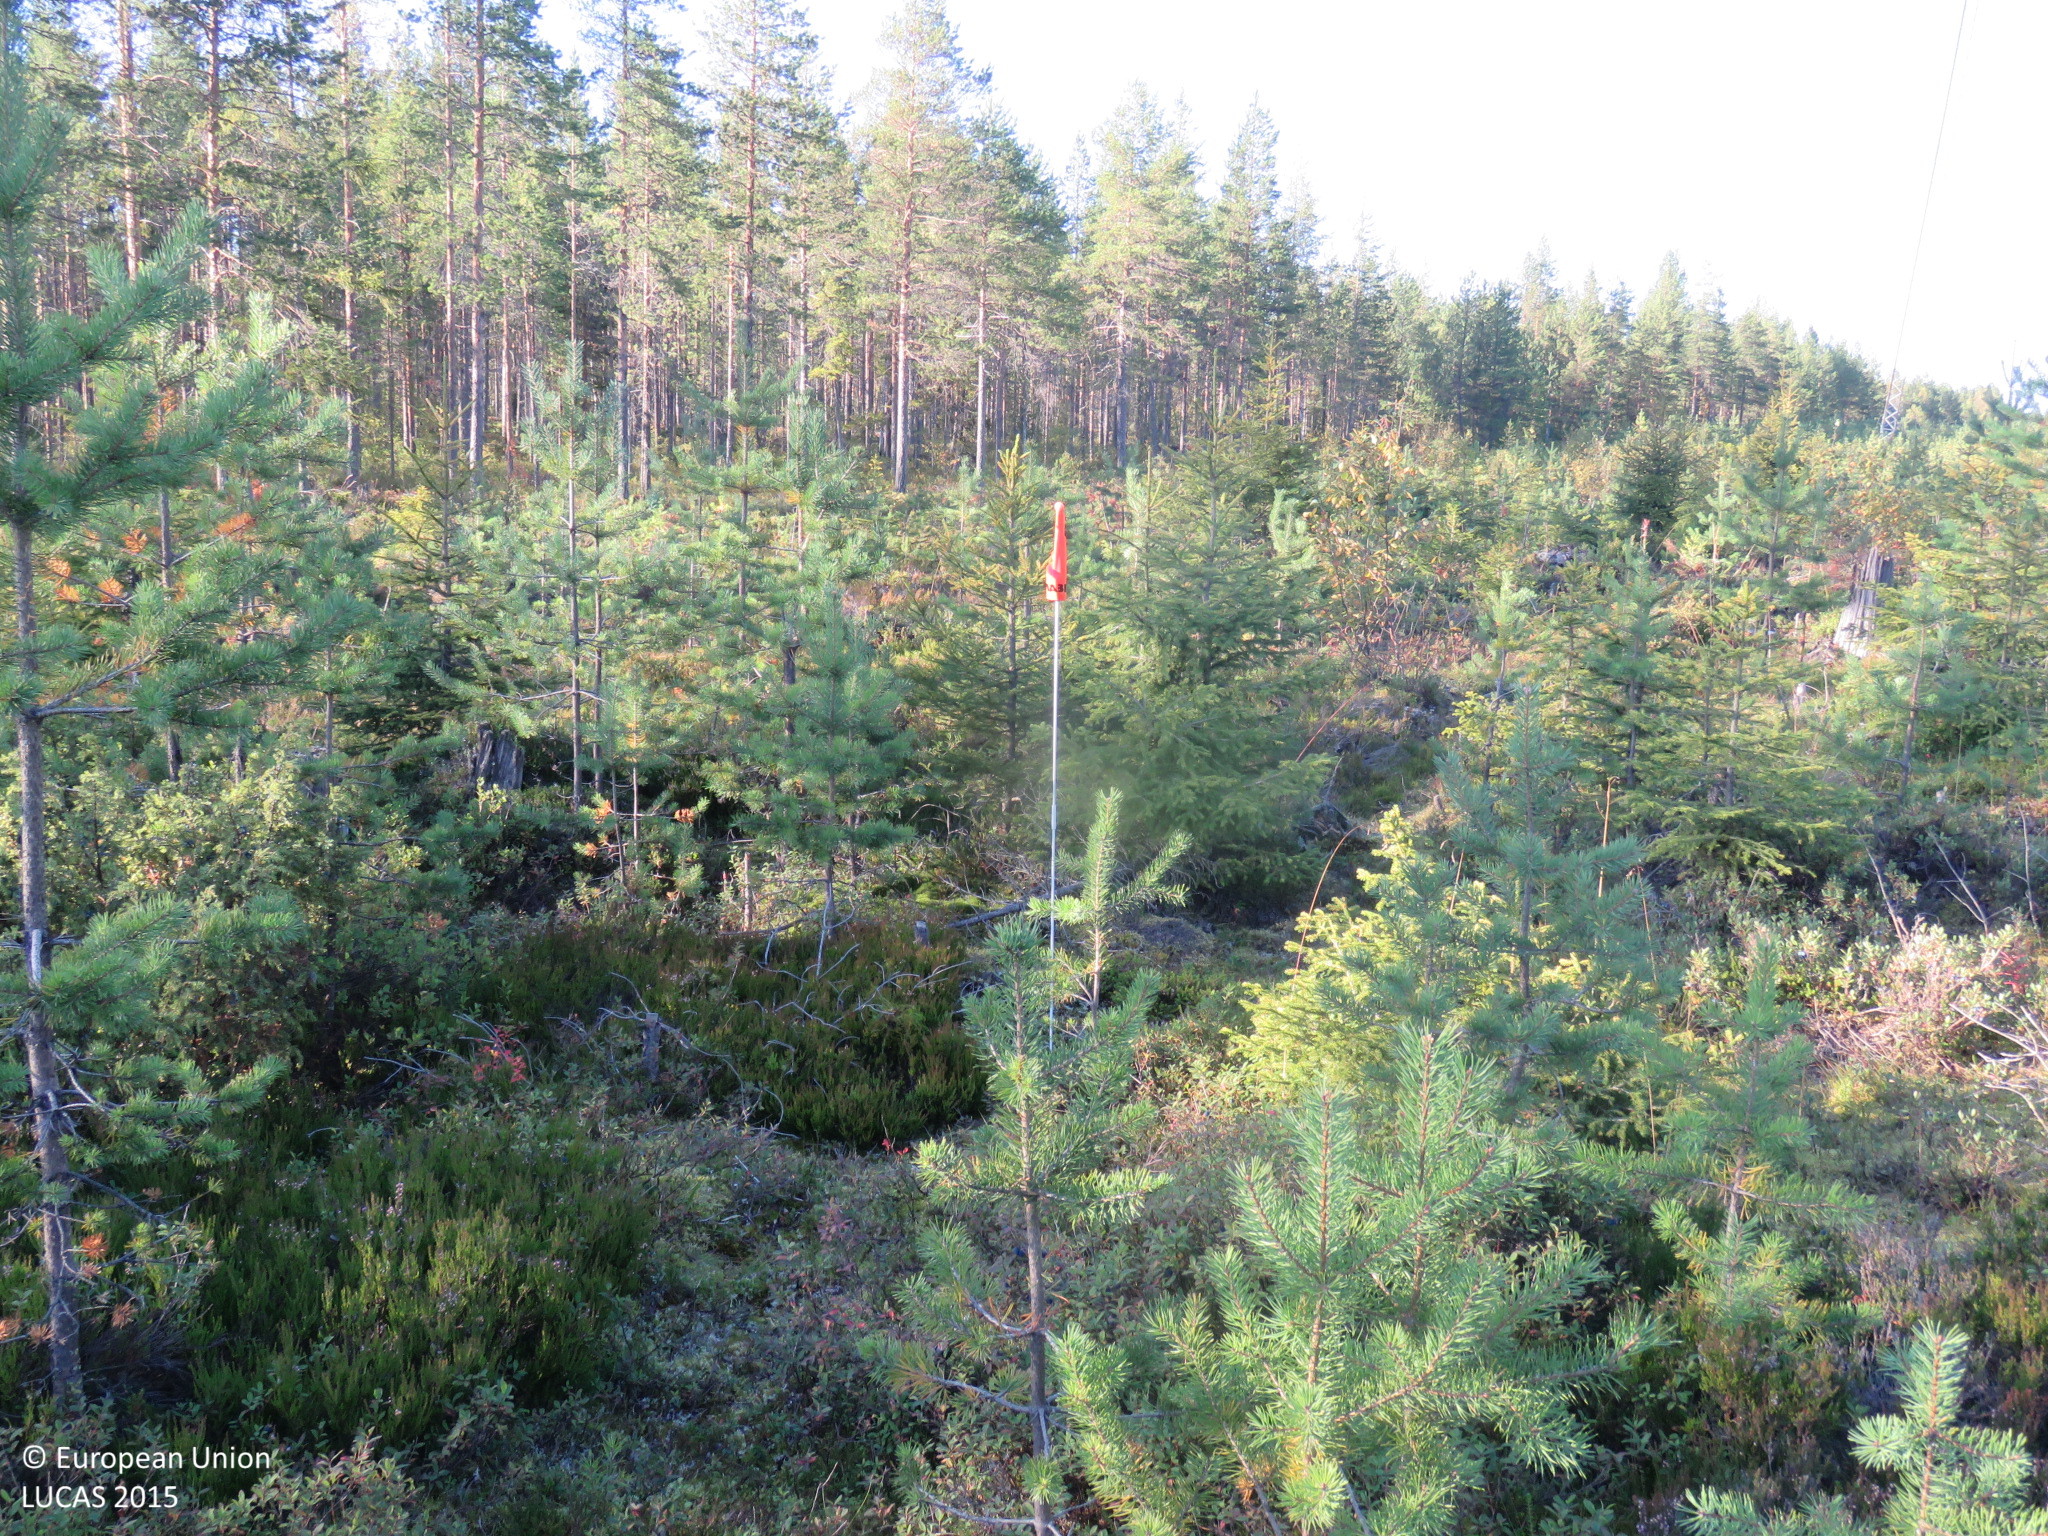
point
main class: Artificial land
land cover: Other artificial areas
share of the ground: > 75 %
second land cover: Other coniferous woodland
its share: 25 - 50 %
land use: Electricity, gas and thermal power distribution
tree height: < 5 m
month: August
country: FI
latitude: 65.3120
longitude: 26.0789
